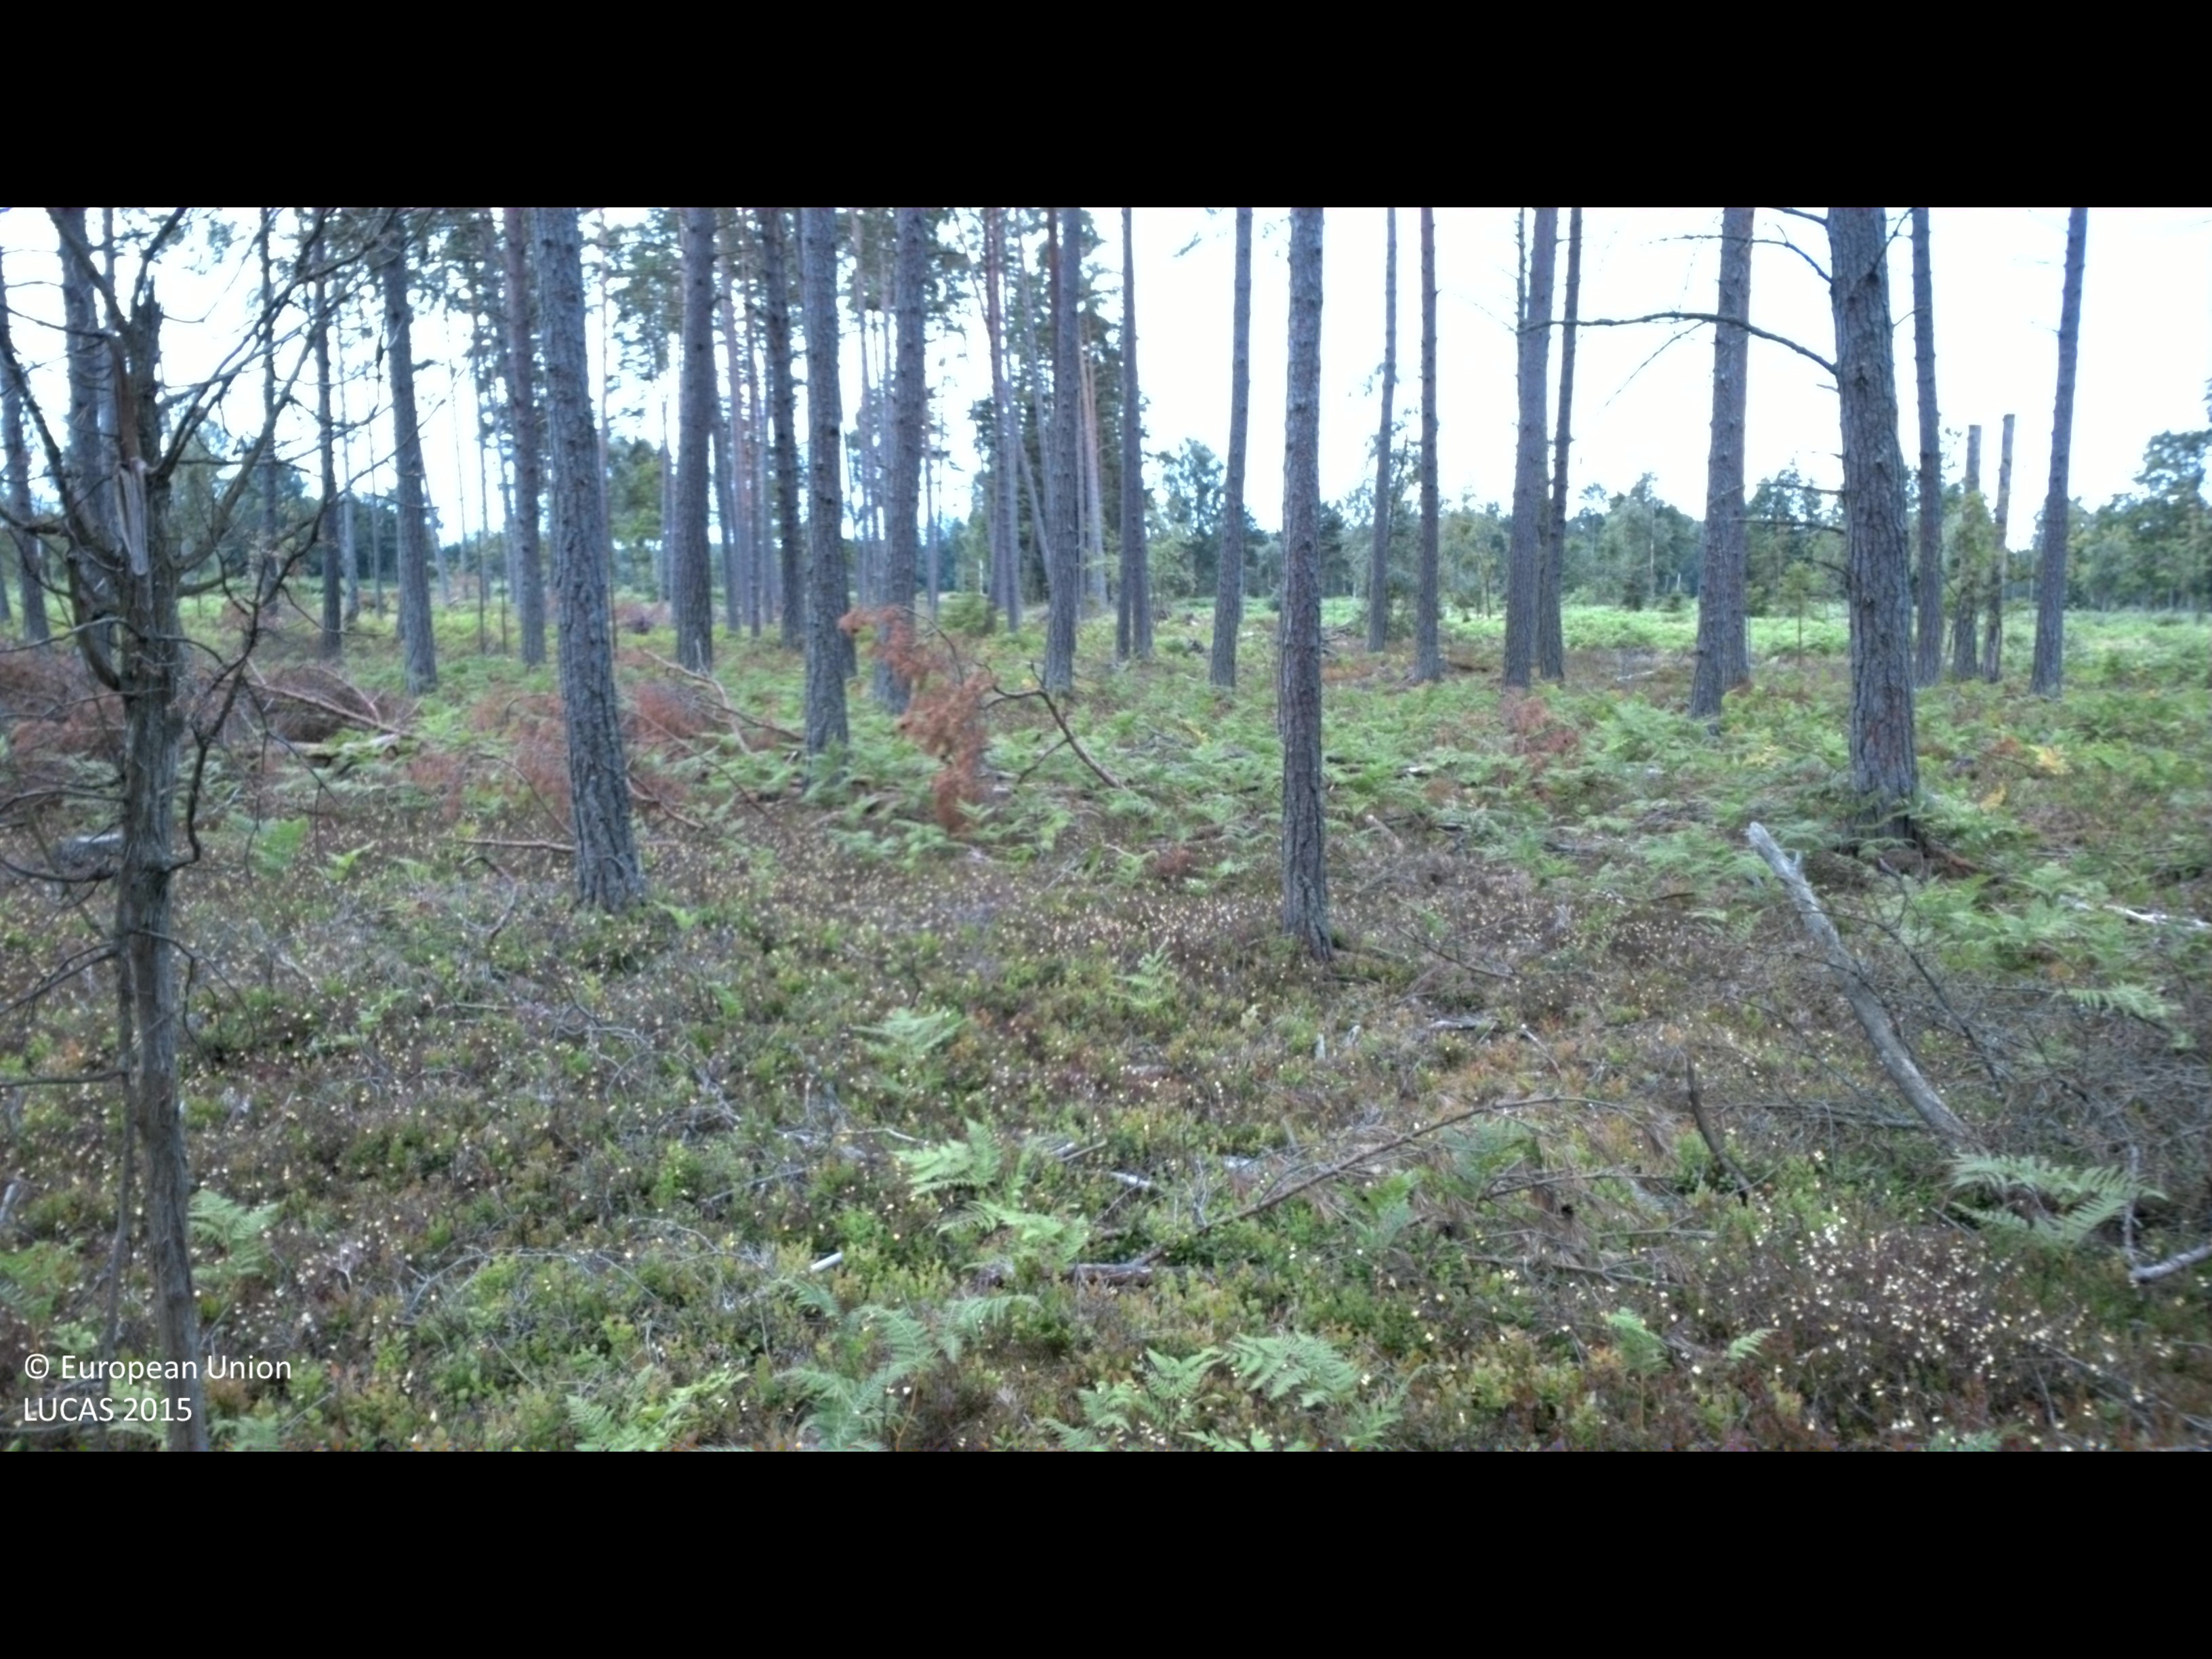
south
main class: Woodland
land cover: Pine dominated coniferous woodland
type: boreal forest
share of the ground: 50 - 75 %
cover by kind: coniferous forest trees 60 %, shrubs 35 %, herbaceous plants 5 %
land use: Forestry
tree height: > 5 m
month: July
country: SE
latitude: 57.2239
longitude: 17.0076
